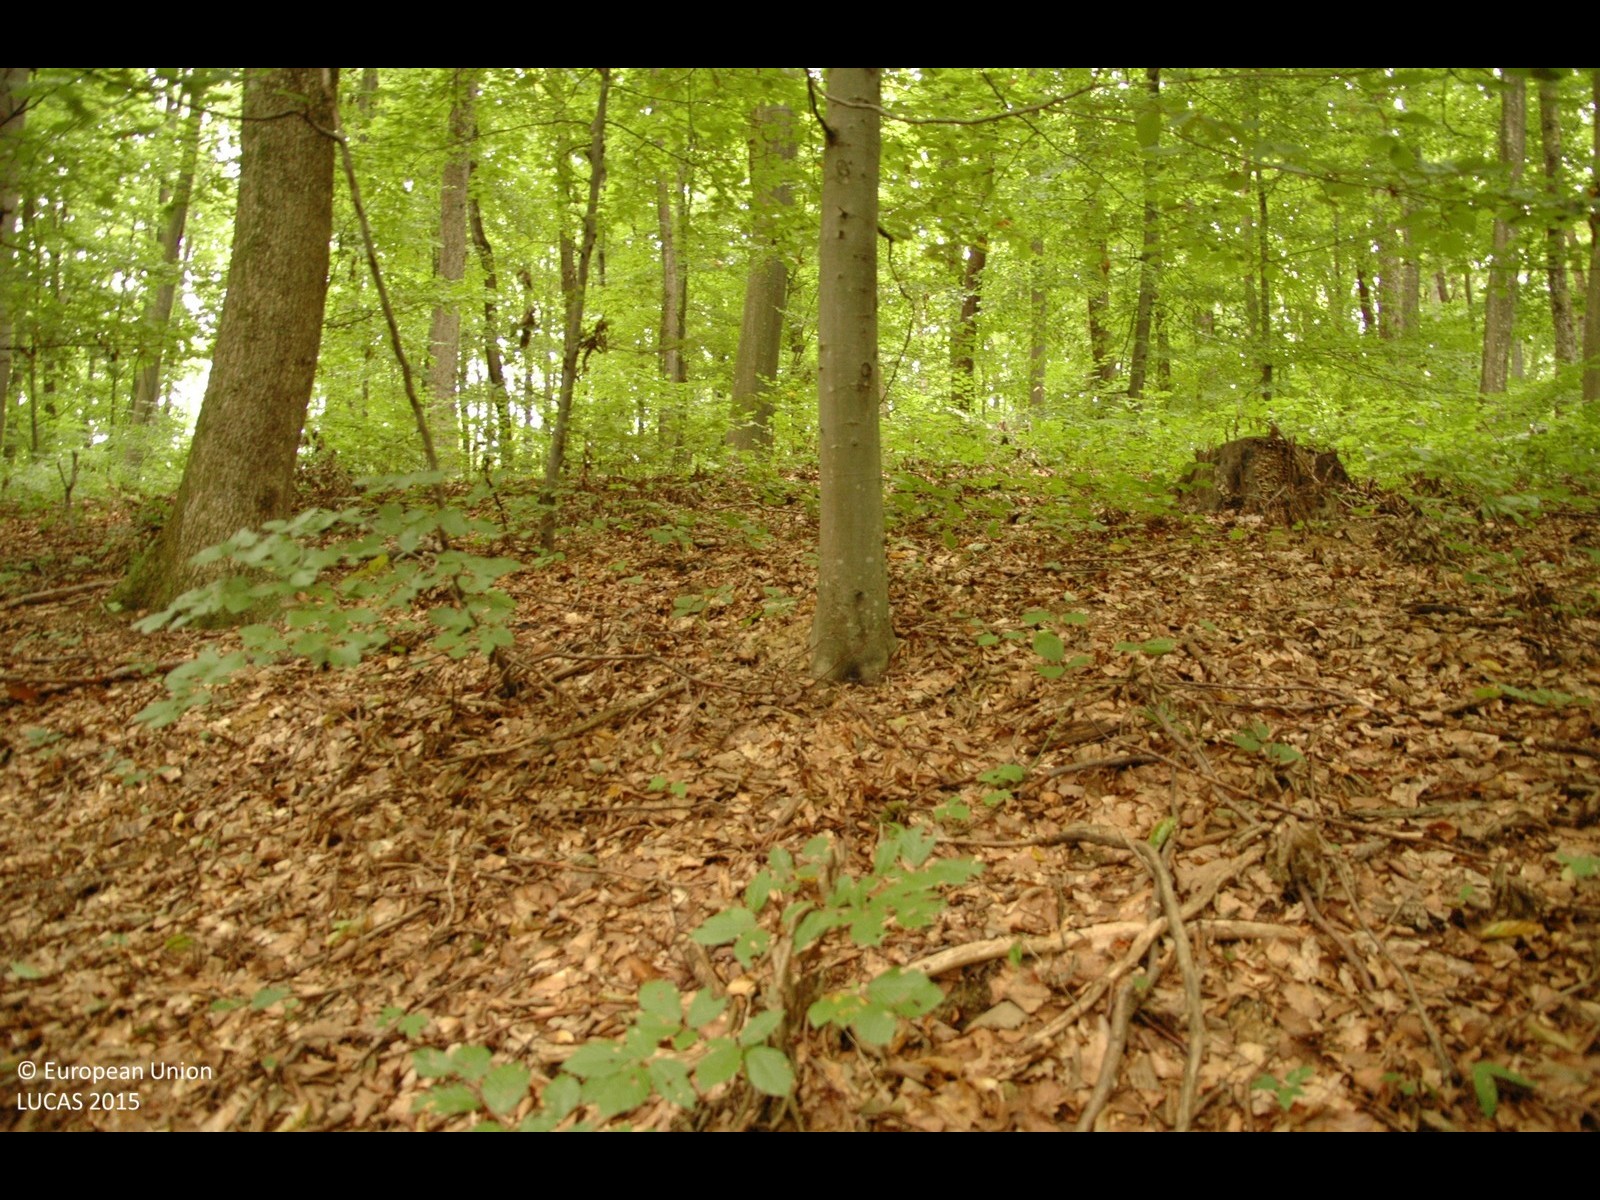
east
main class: Woodland
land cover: Broadleaved woodland
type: beech forest
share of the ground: > 75 %
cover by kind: broadleaved forest trees 100 %
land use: Forestry
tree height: > 5 m
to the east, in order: Broadleaved woodland
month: September
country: HR
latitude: 46.0877
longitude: 16.6868
